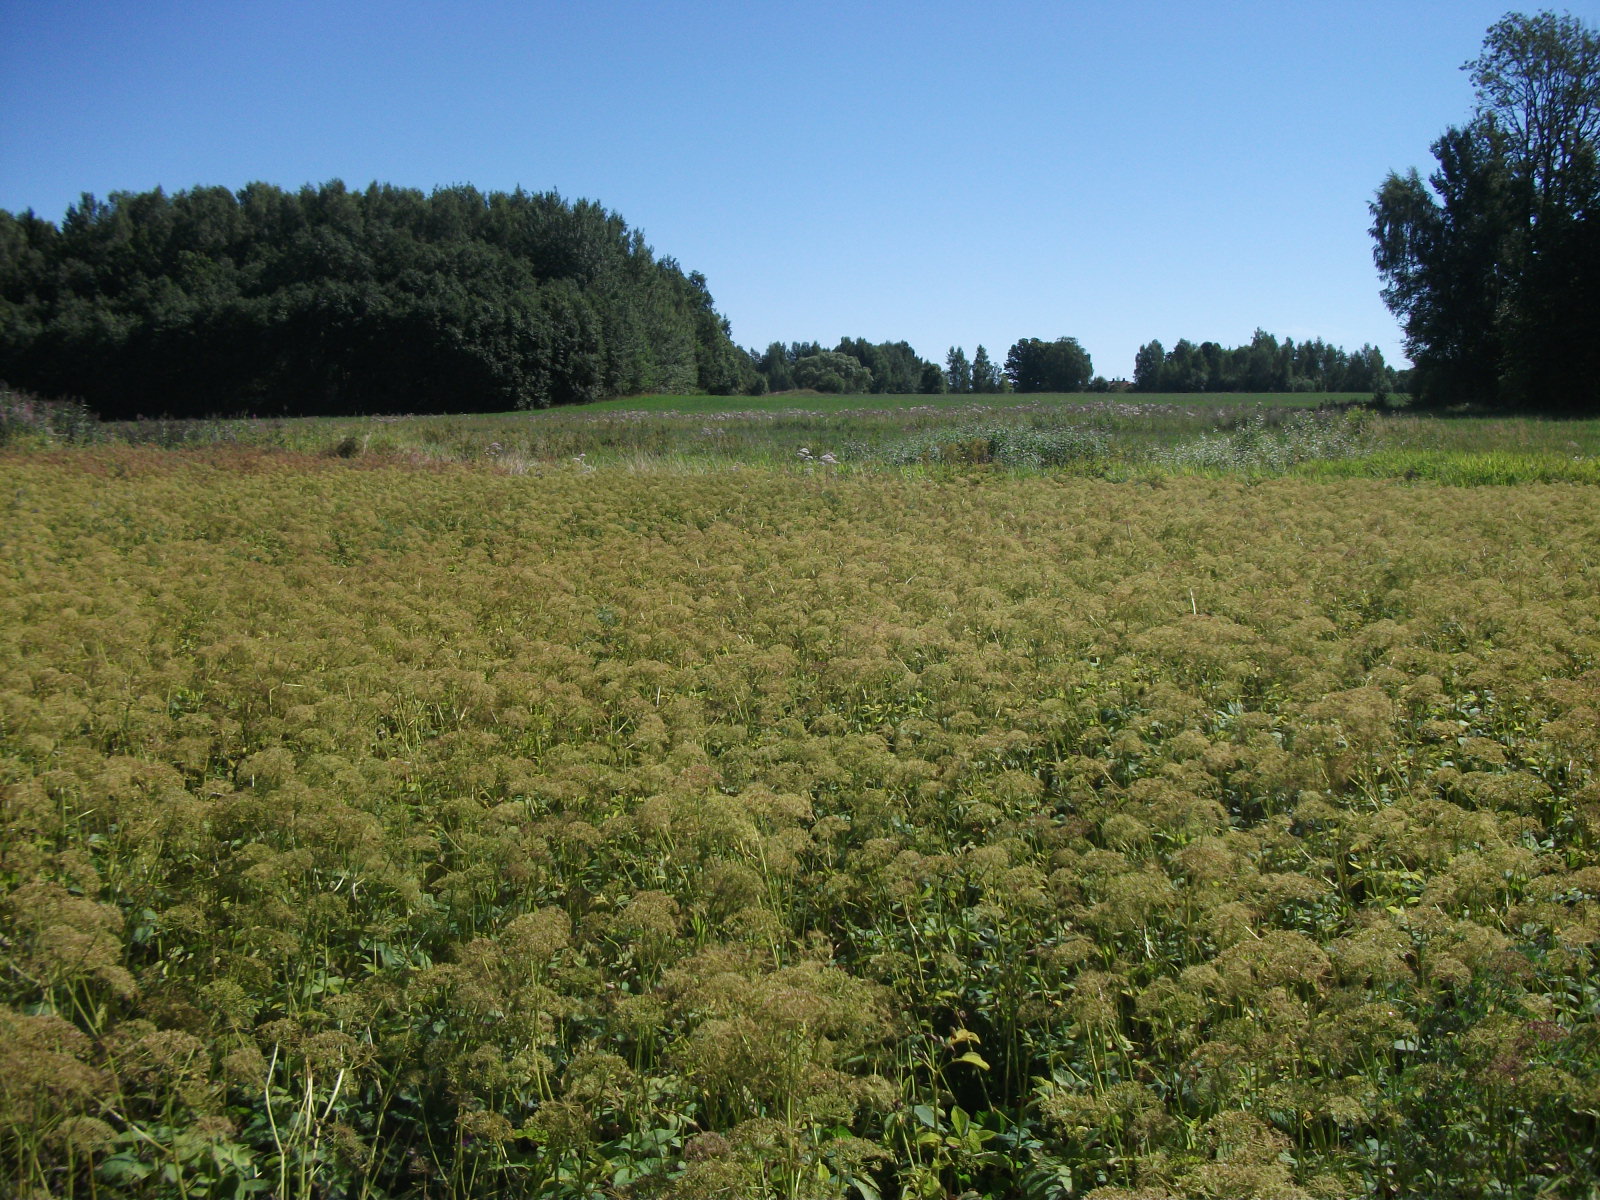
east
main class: Grassland
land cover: Spontaneously vegetated surfaces
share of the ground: > 75 %
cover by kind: herbaceous plants 100 %
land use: Abandoned areas
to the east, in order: Spontaneously vegetated surfaces; Lucerne; Spontaneously vegetated surfaces; Lucerne
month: August
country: LV
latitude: 57.0265
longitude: 26.4705
